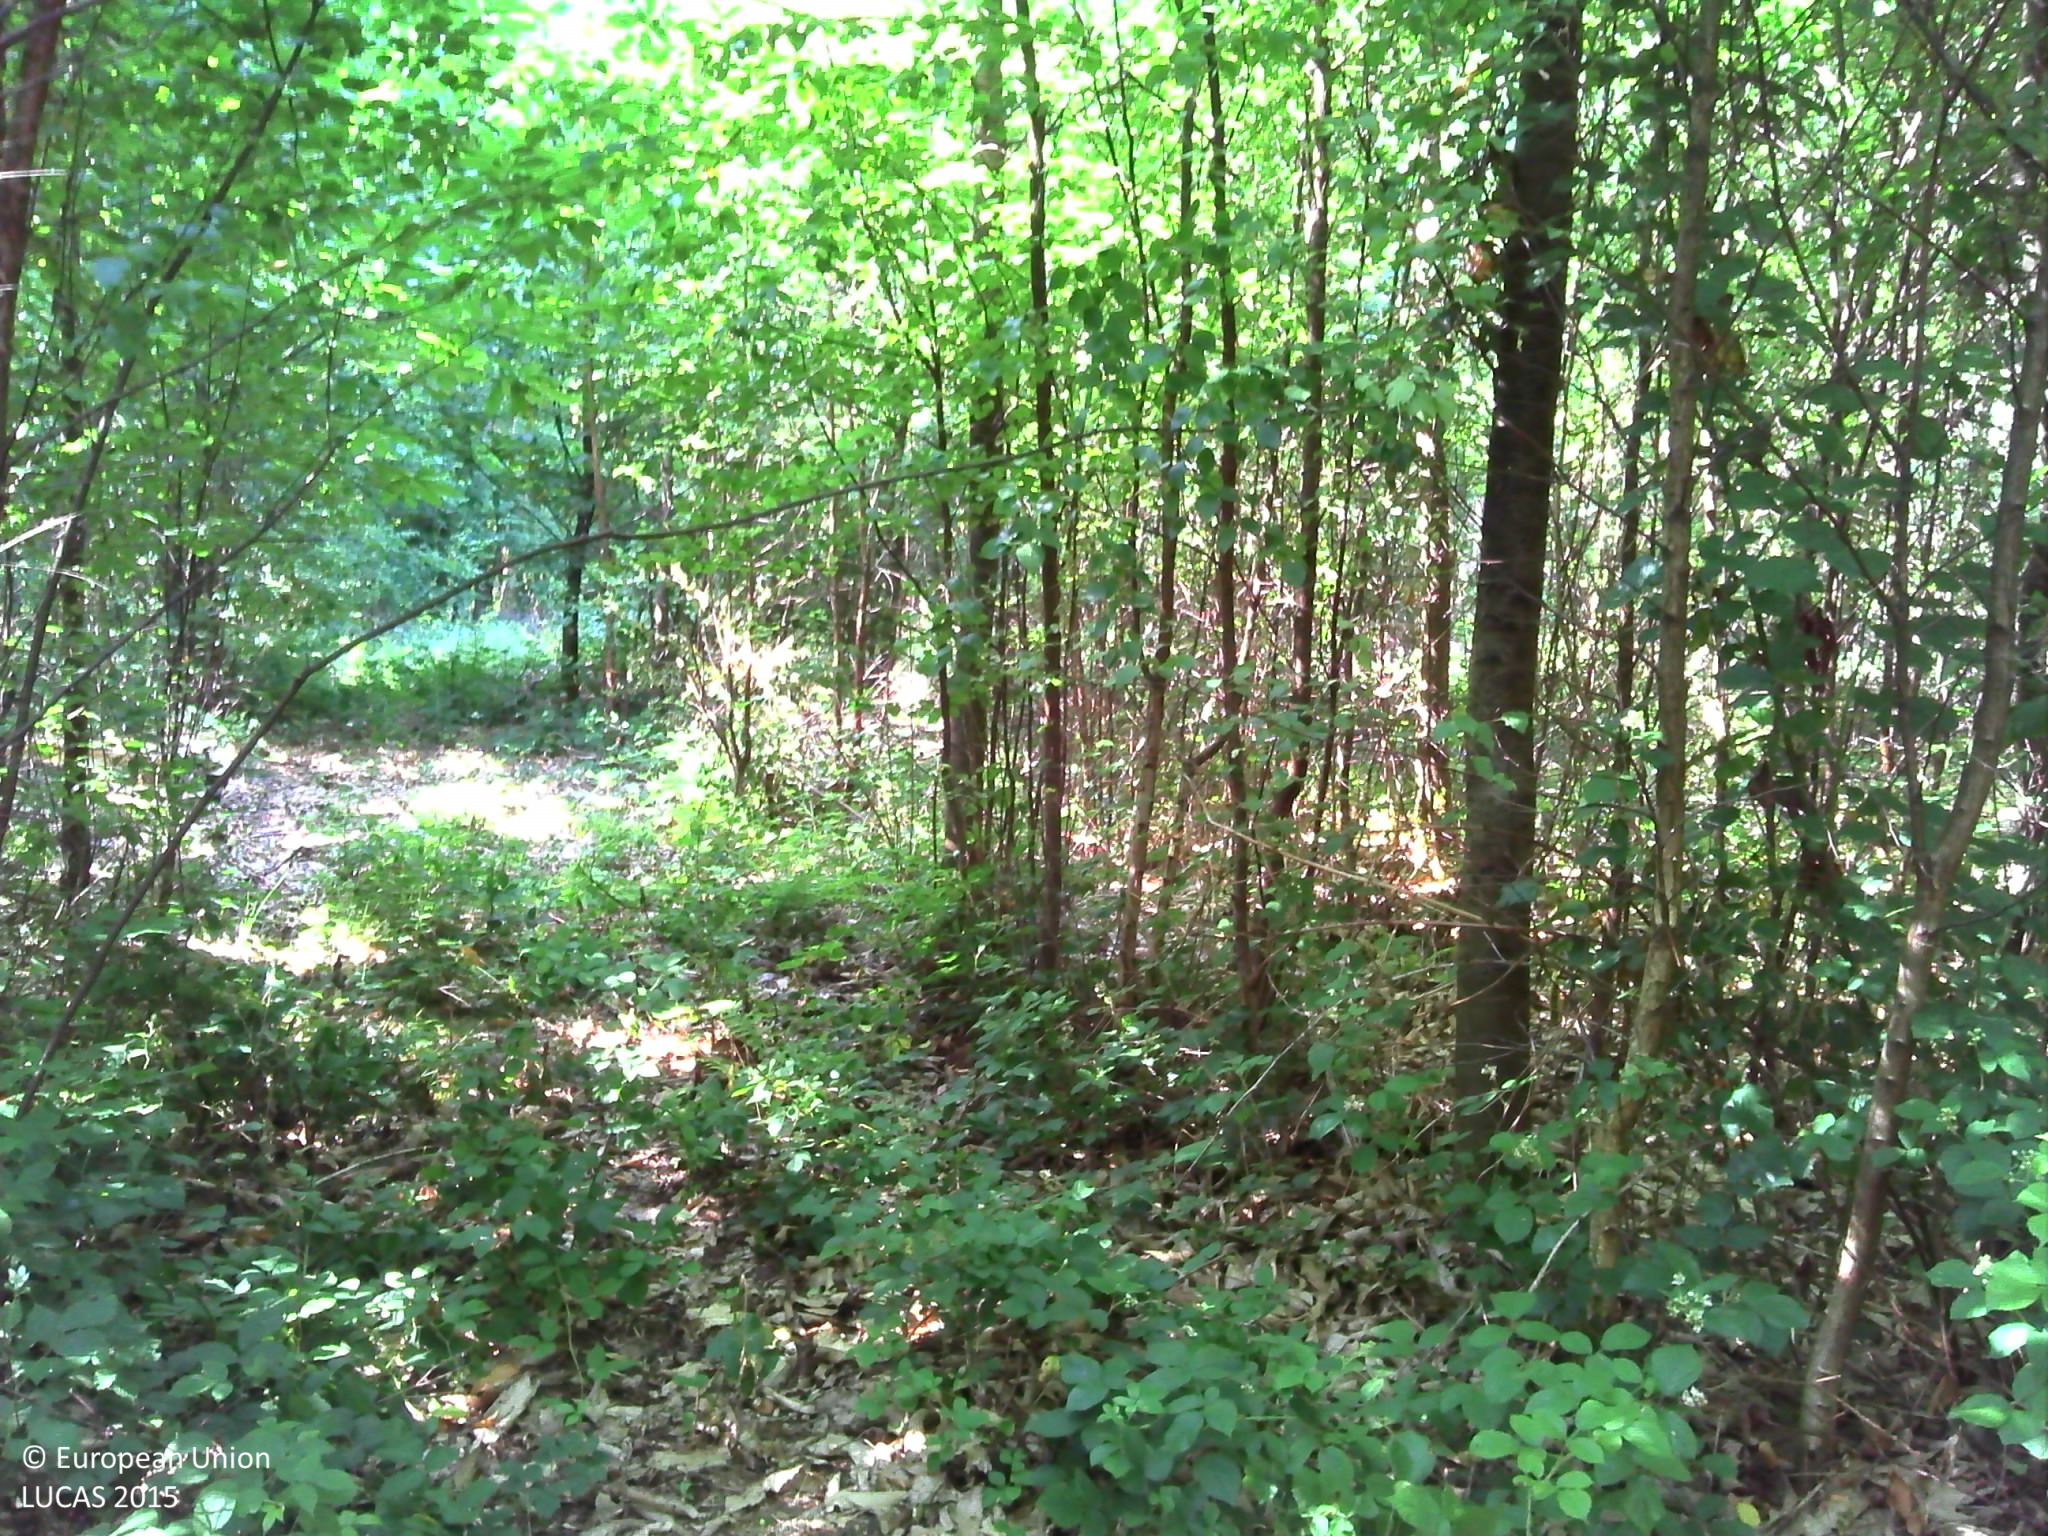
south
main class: Woodland
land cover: Broadleaved woodland
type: exotic forest
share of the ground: > 75 %
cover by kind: broadleaved forest trees 85 %, herbaceous plants 10 %, unconsolidated bare surface 5 %
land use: Forestry
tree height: > 5 m
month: July
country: BE
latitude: 50.2876
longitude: 4.5363
